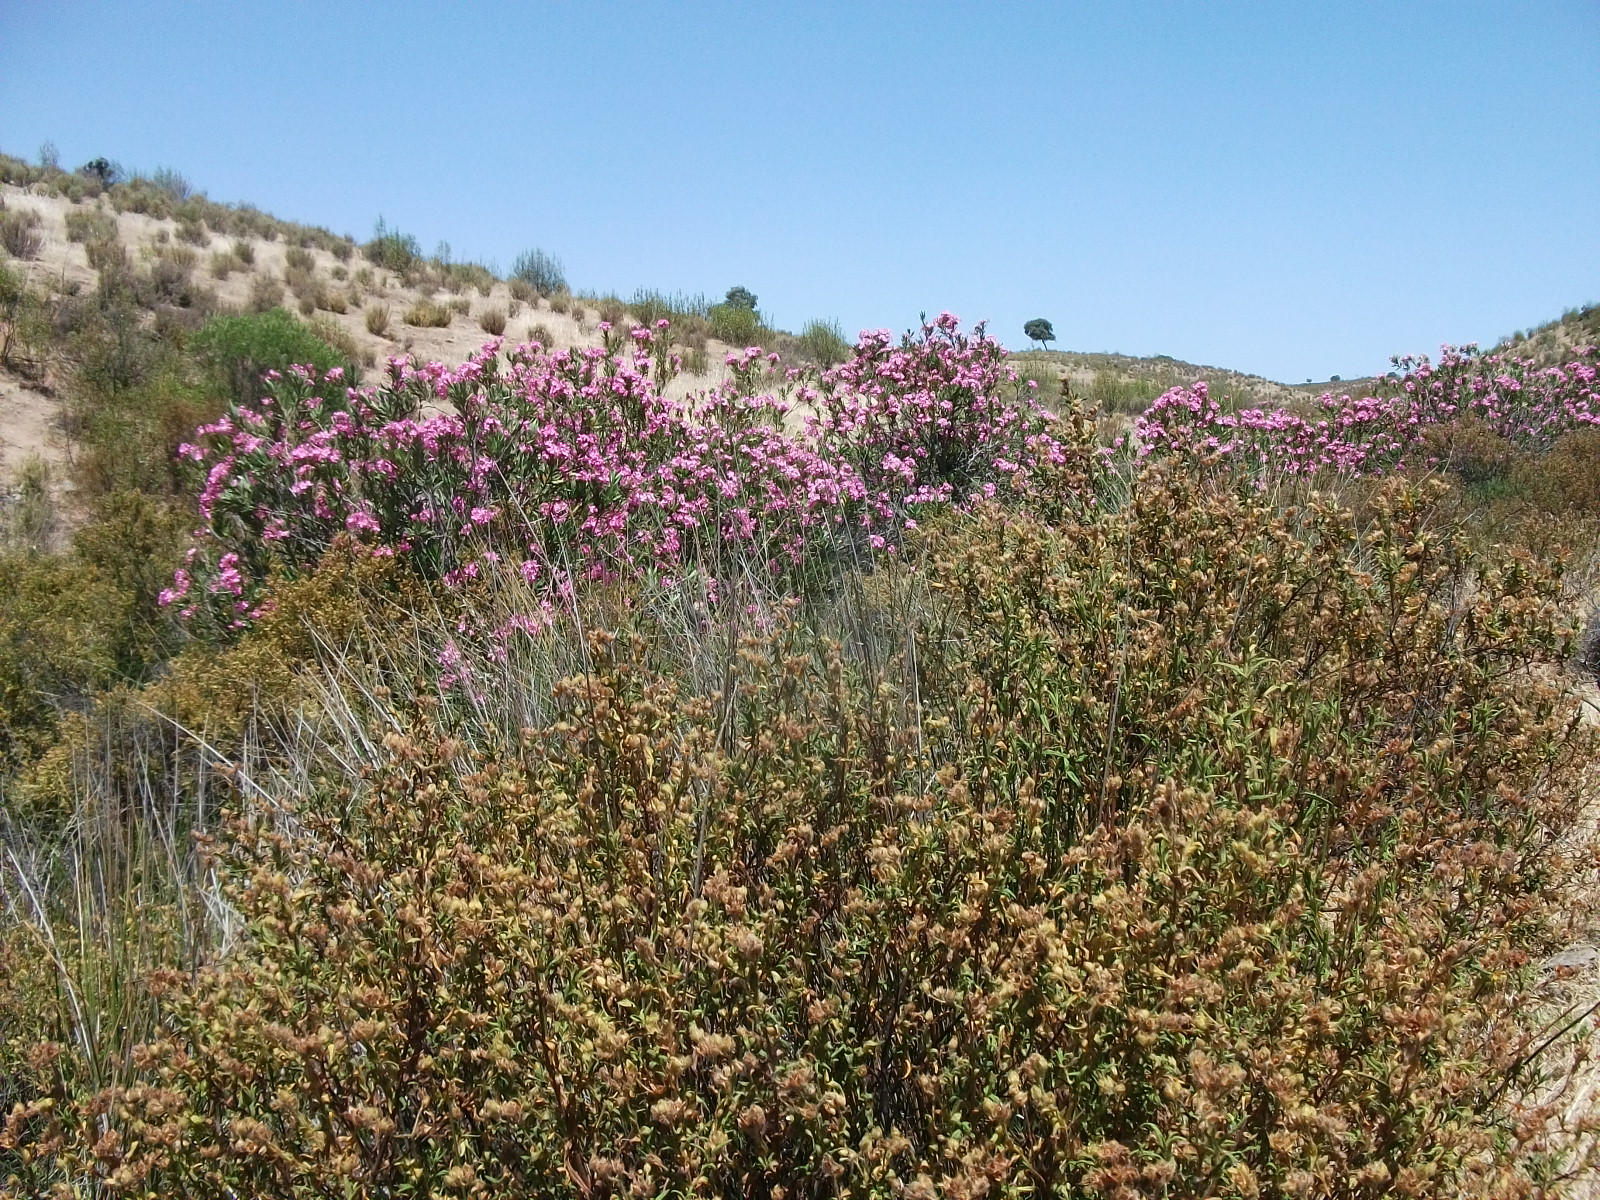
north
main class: Shrubland
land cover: Shrubland without tree cover
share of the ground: 25 - 50 %
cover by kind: shrubs 45 %, herbaceous plants 40 %, unconsolidated bare surface 15 %
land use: Agriculture (excluding fallow land and kitchen gardens)
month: June
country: ES
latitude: 37.5670
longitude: -6.9246
